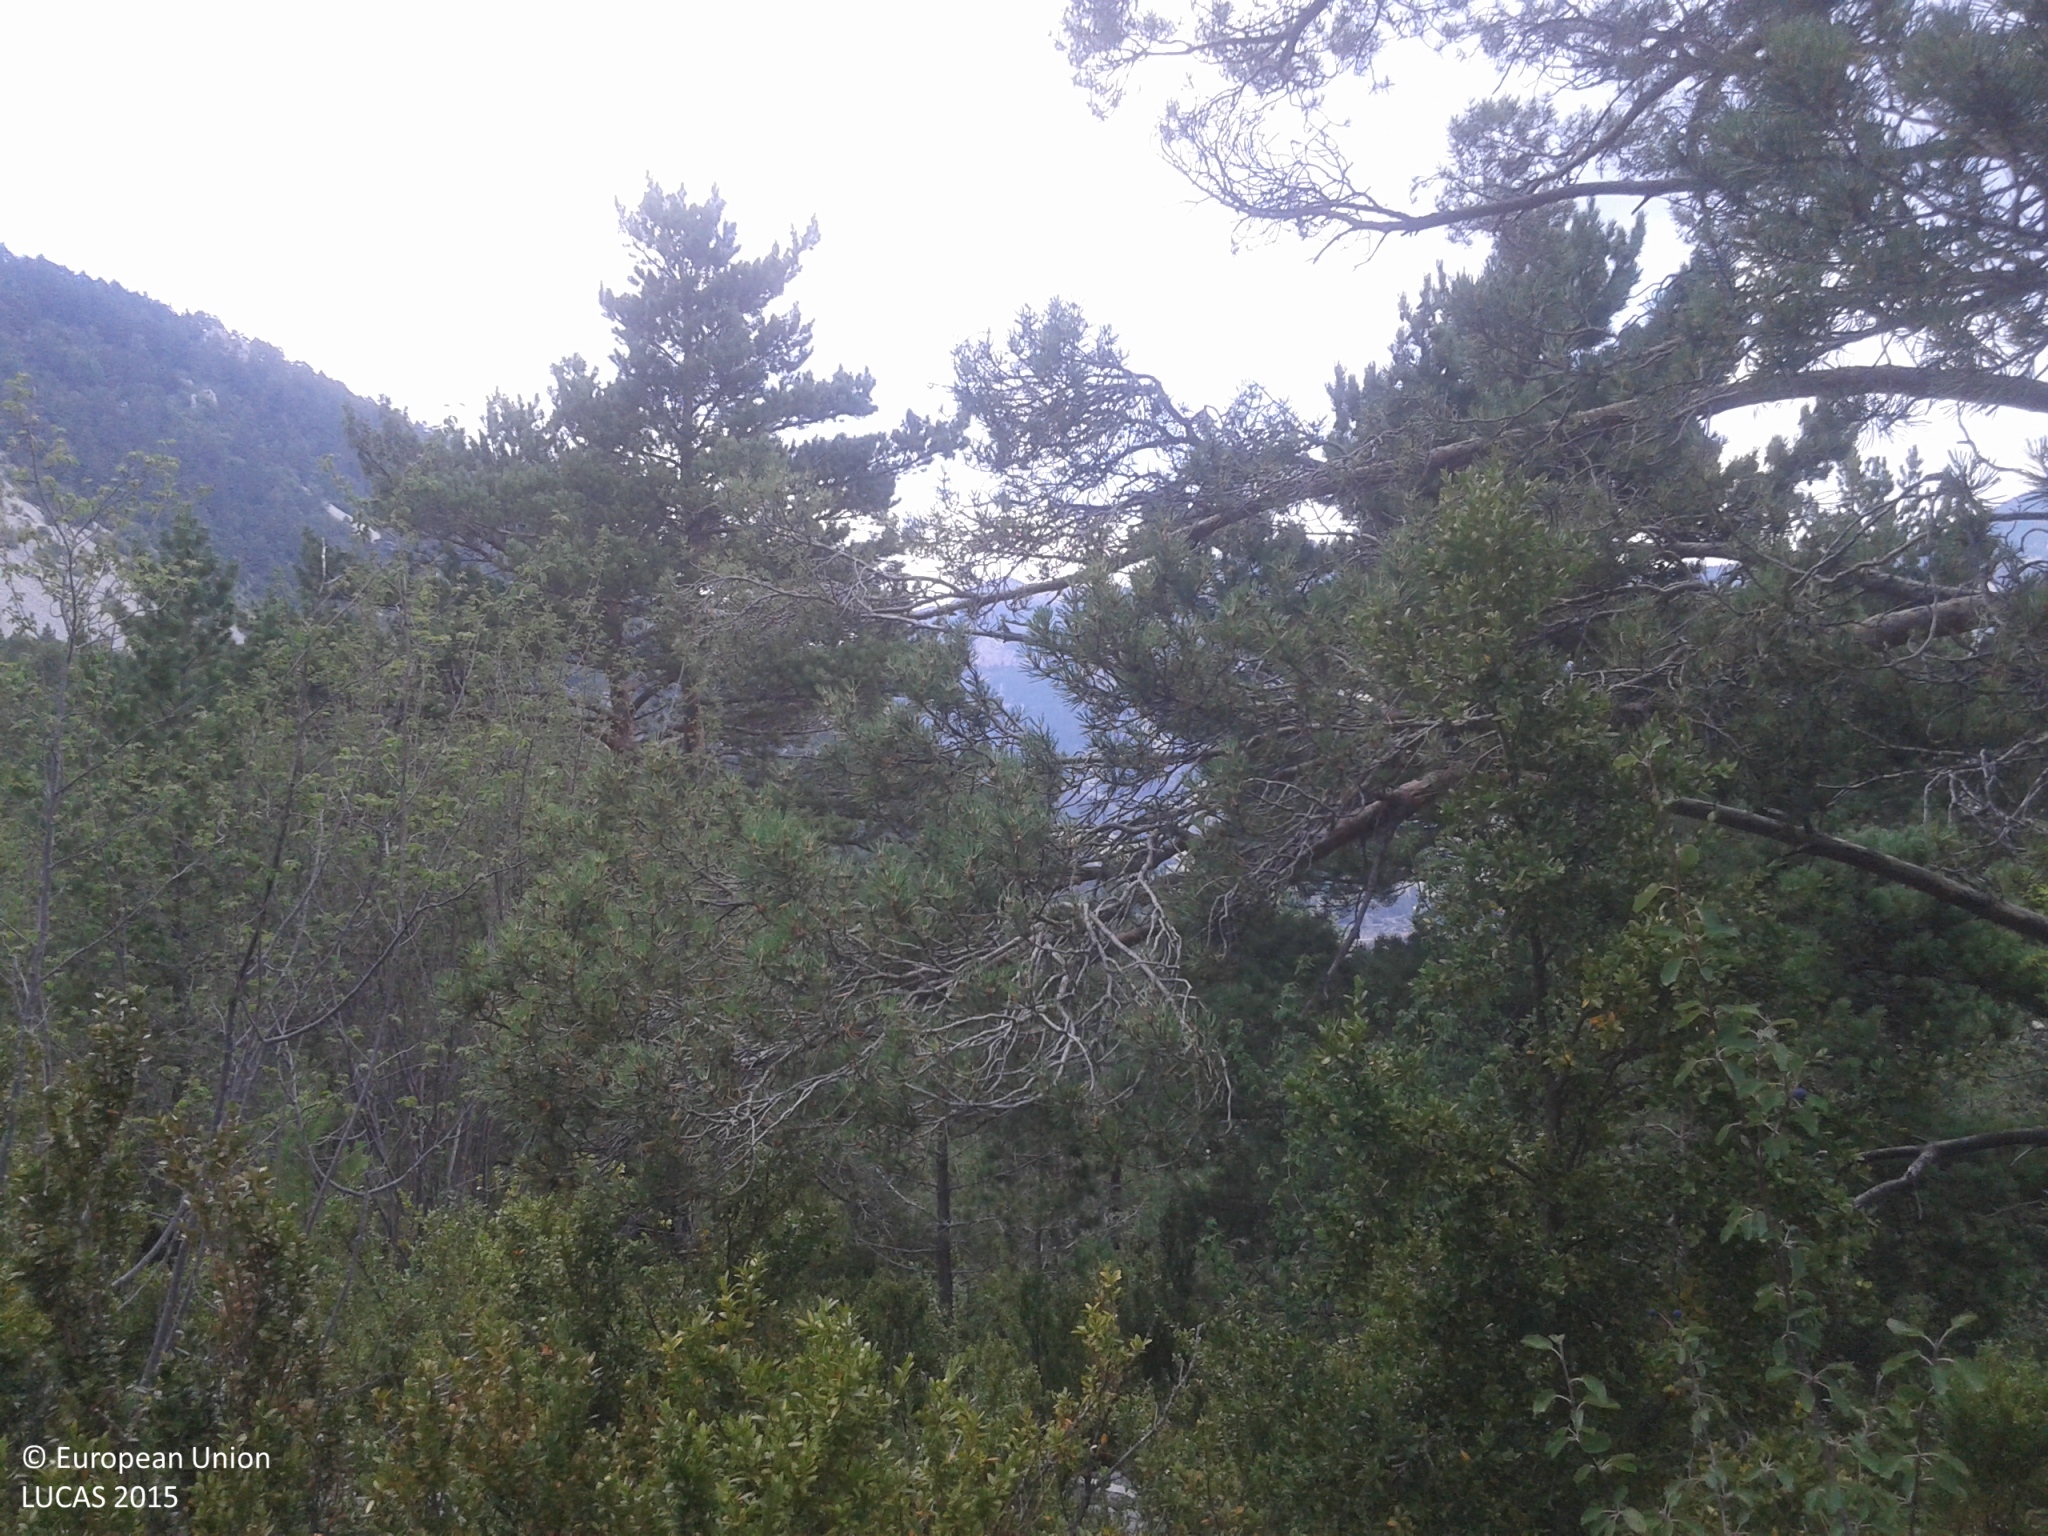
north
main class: Woodland
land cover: Pine dominated coniferous woodland
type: alpine coniferous forest
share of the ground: 25 - 50 %
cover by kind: consolidated bare surface 40 %, shrubs 30 %, coniferous forest trees 25 %, herbaceous plants 5 %
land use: Semi-natural and natural areas not in use
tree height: > 5 m
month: July
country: ES
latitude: 42.1753
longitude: 1.5736
